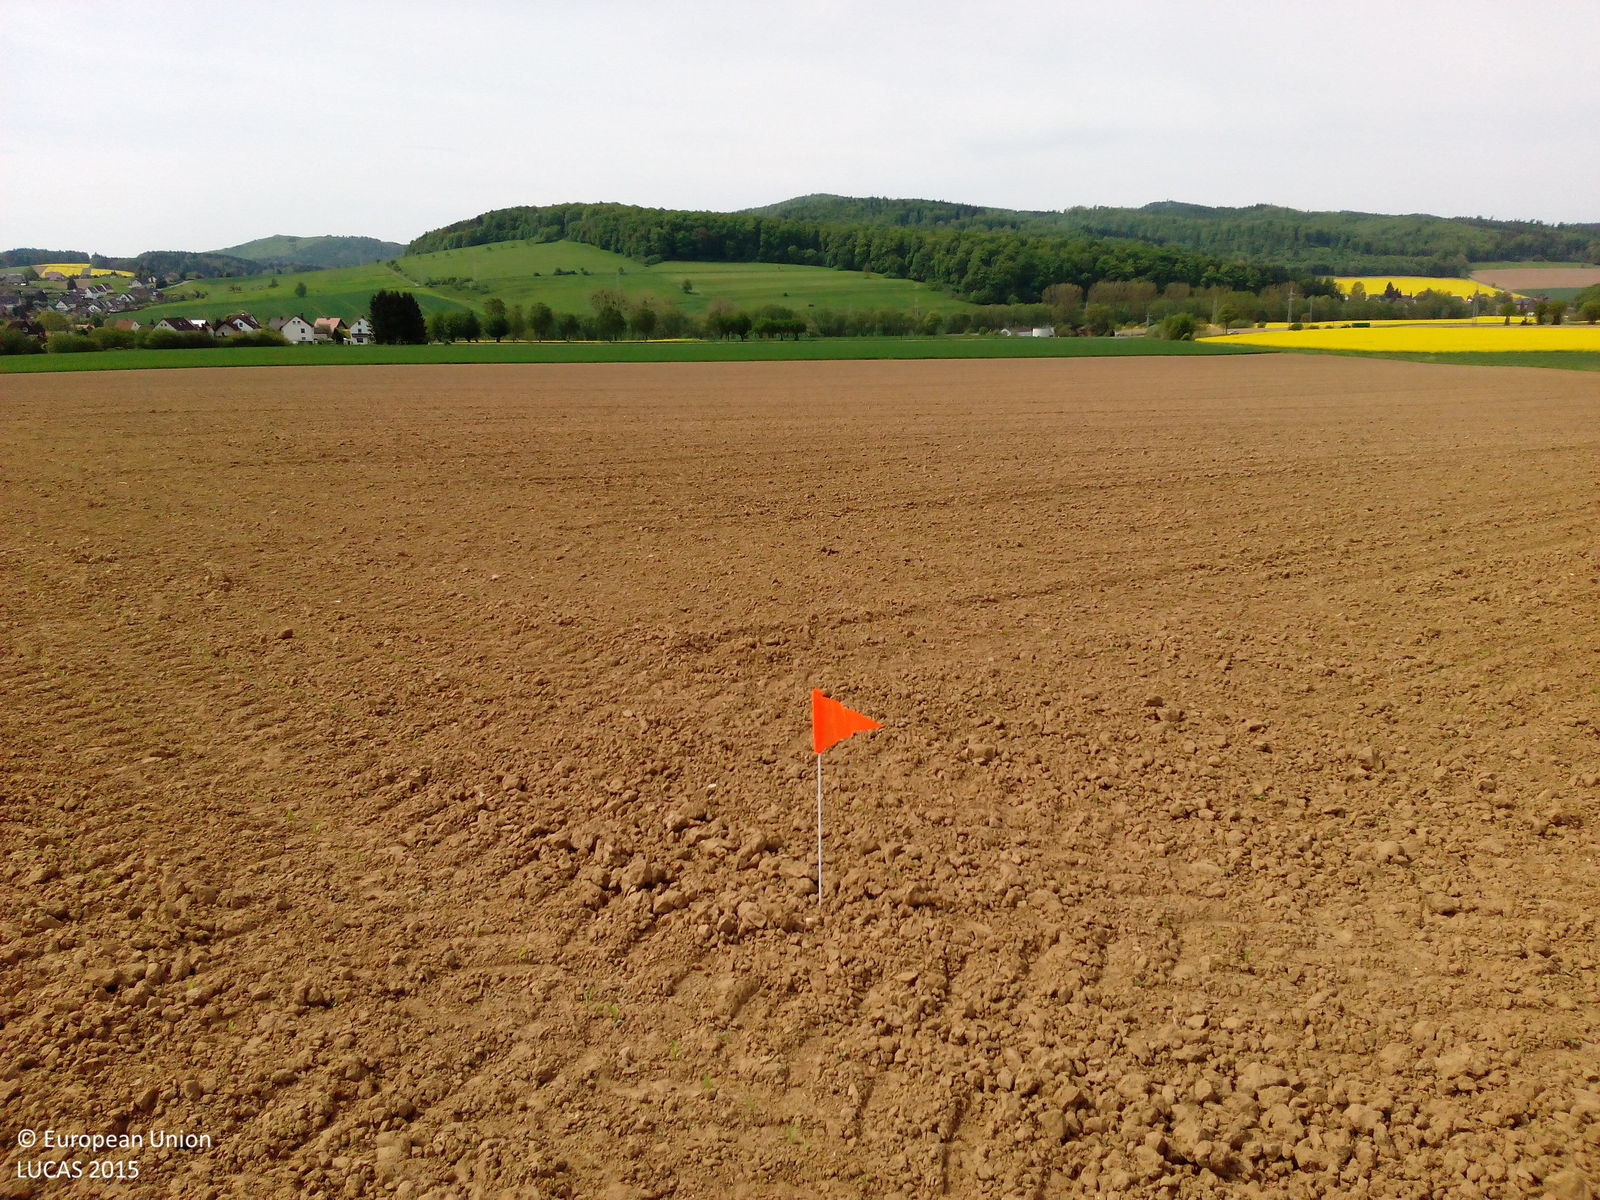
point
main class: Cropland
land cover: Maize
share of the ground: < 10 %
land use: Agriculture (excluding fallow land and kitchen gardens)
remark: Tilled/Sowed
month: May
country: DE
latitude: 51.9455
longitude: 9.6364
